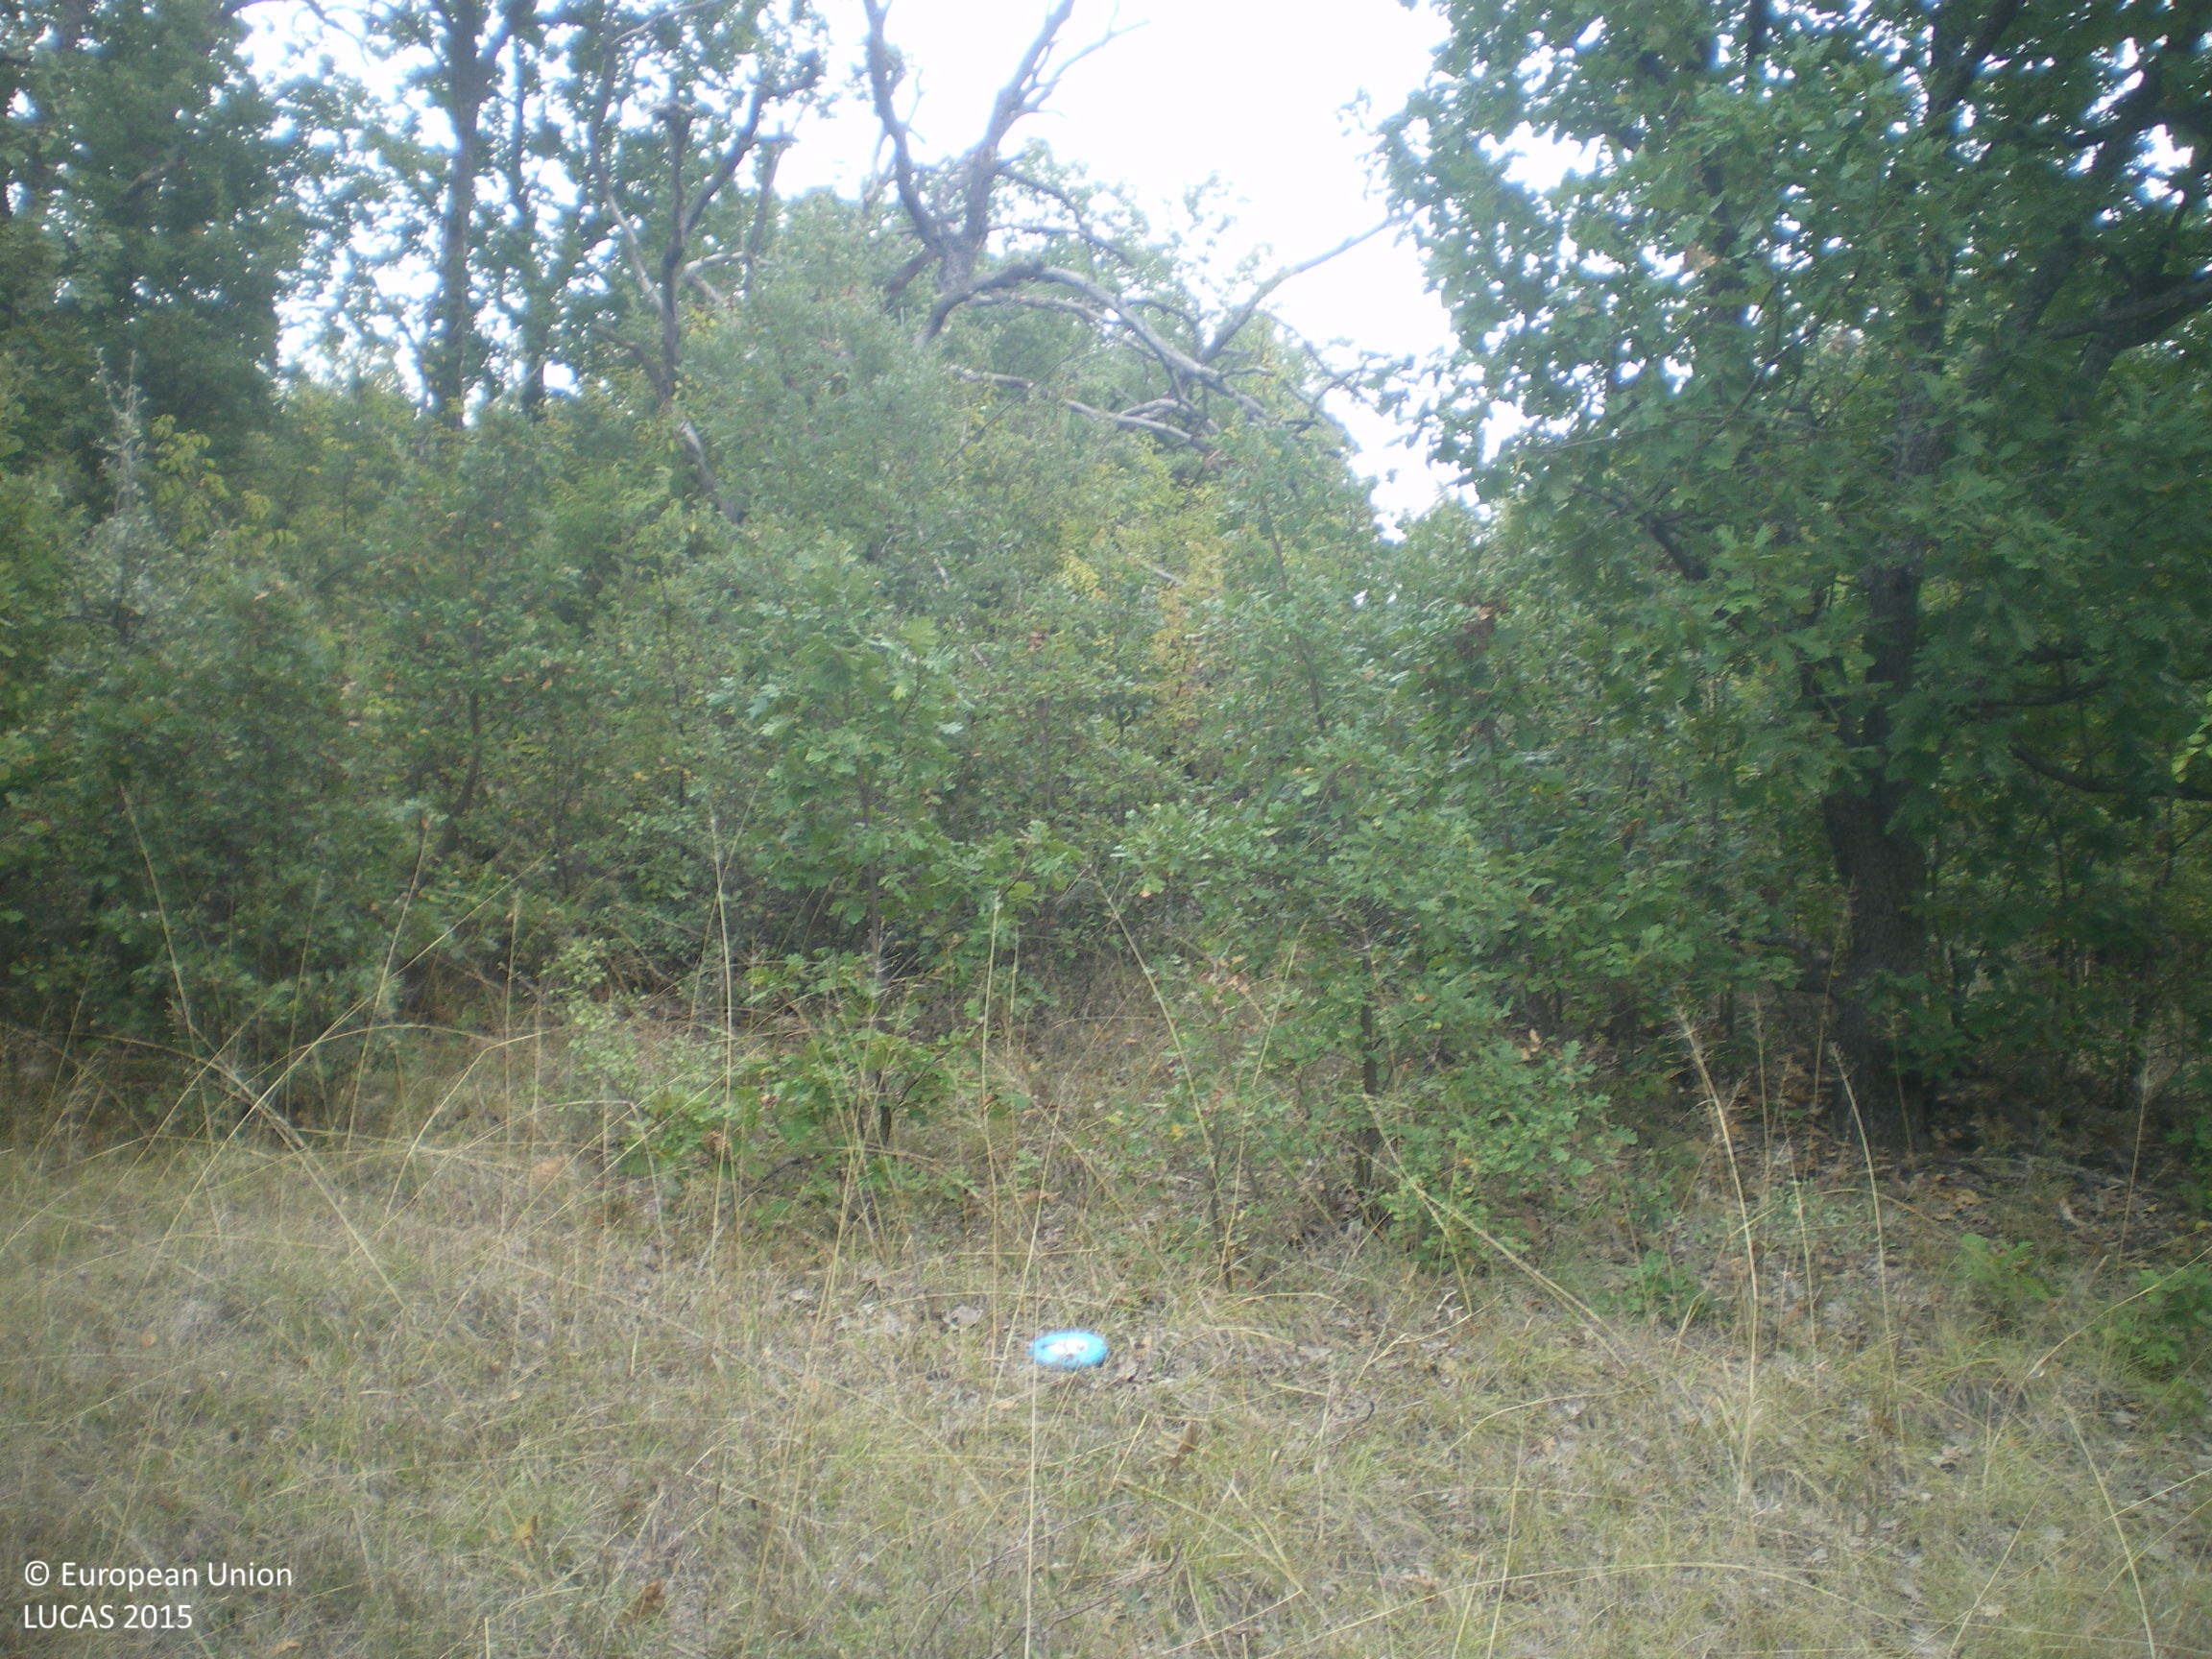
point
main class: Woodland
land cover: Broadleaved woodland
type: mesophytic deciduous forest
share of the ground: > 75 %
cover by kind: broadleaved forest trees 75 %, herbaceous plants 15 %, shrubs 10 %
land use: Forestry
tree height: > 5 m
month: October
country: BG
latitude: 41.9631
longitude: 26.2106
